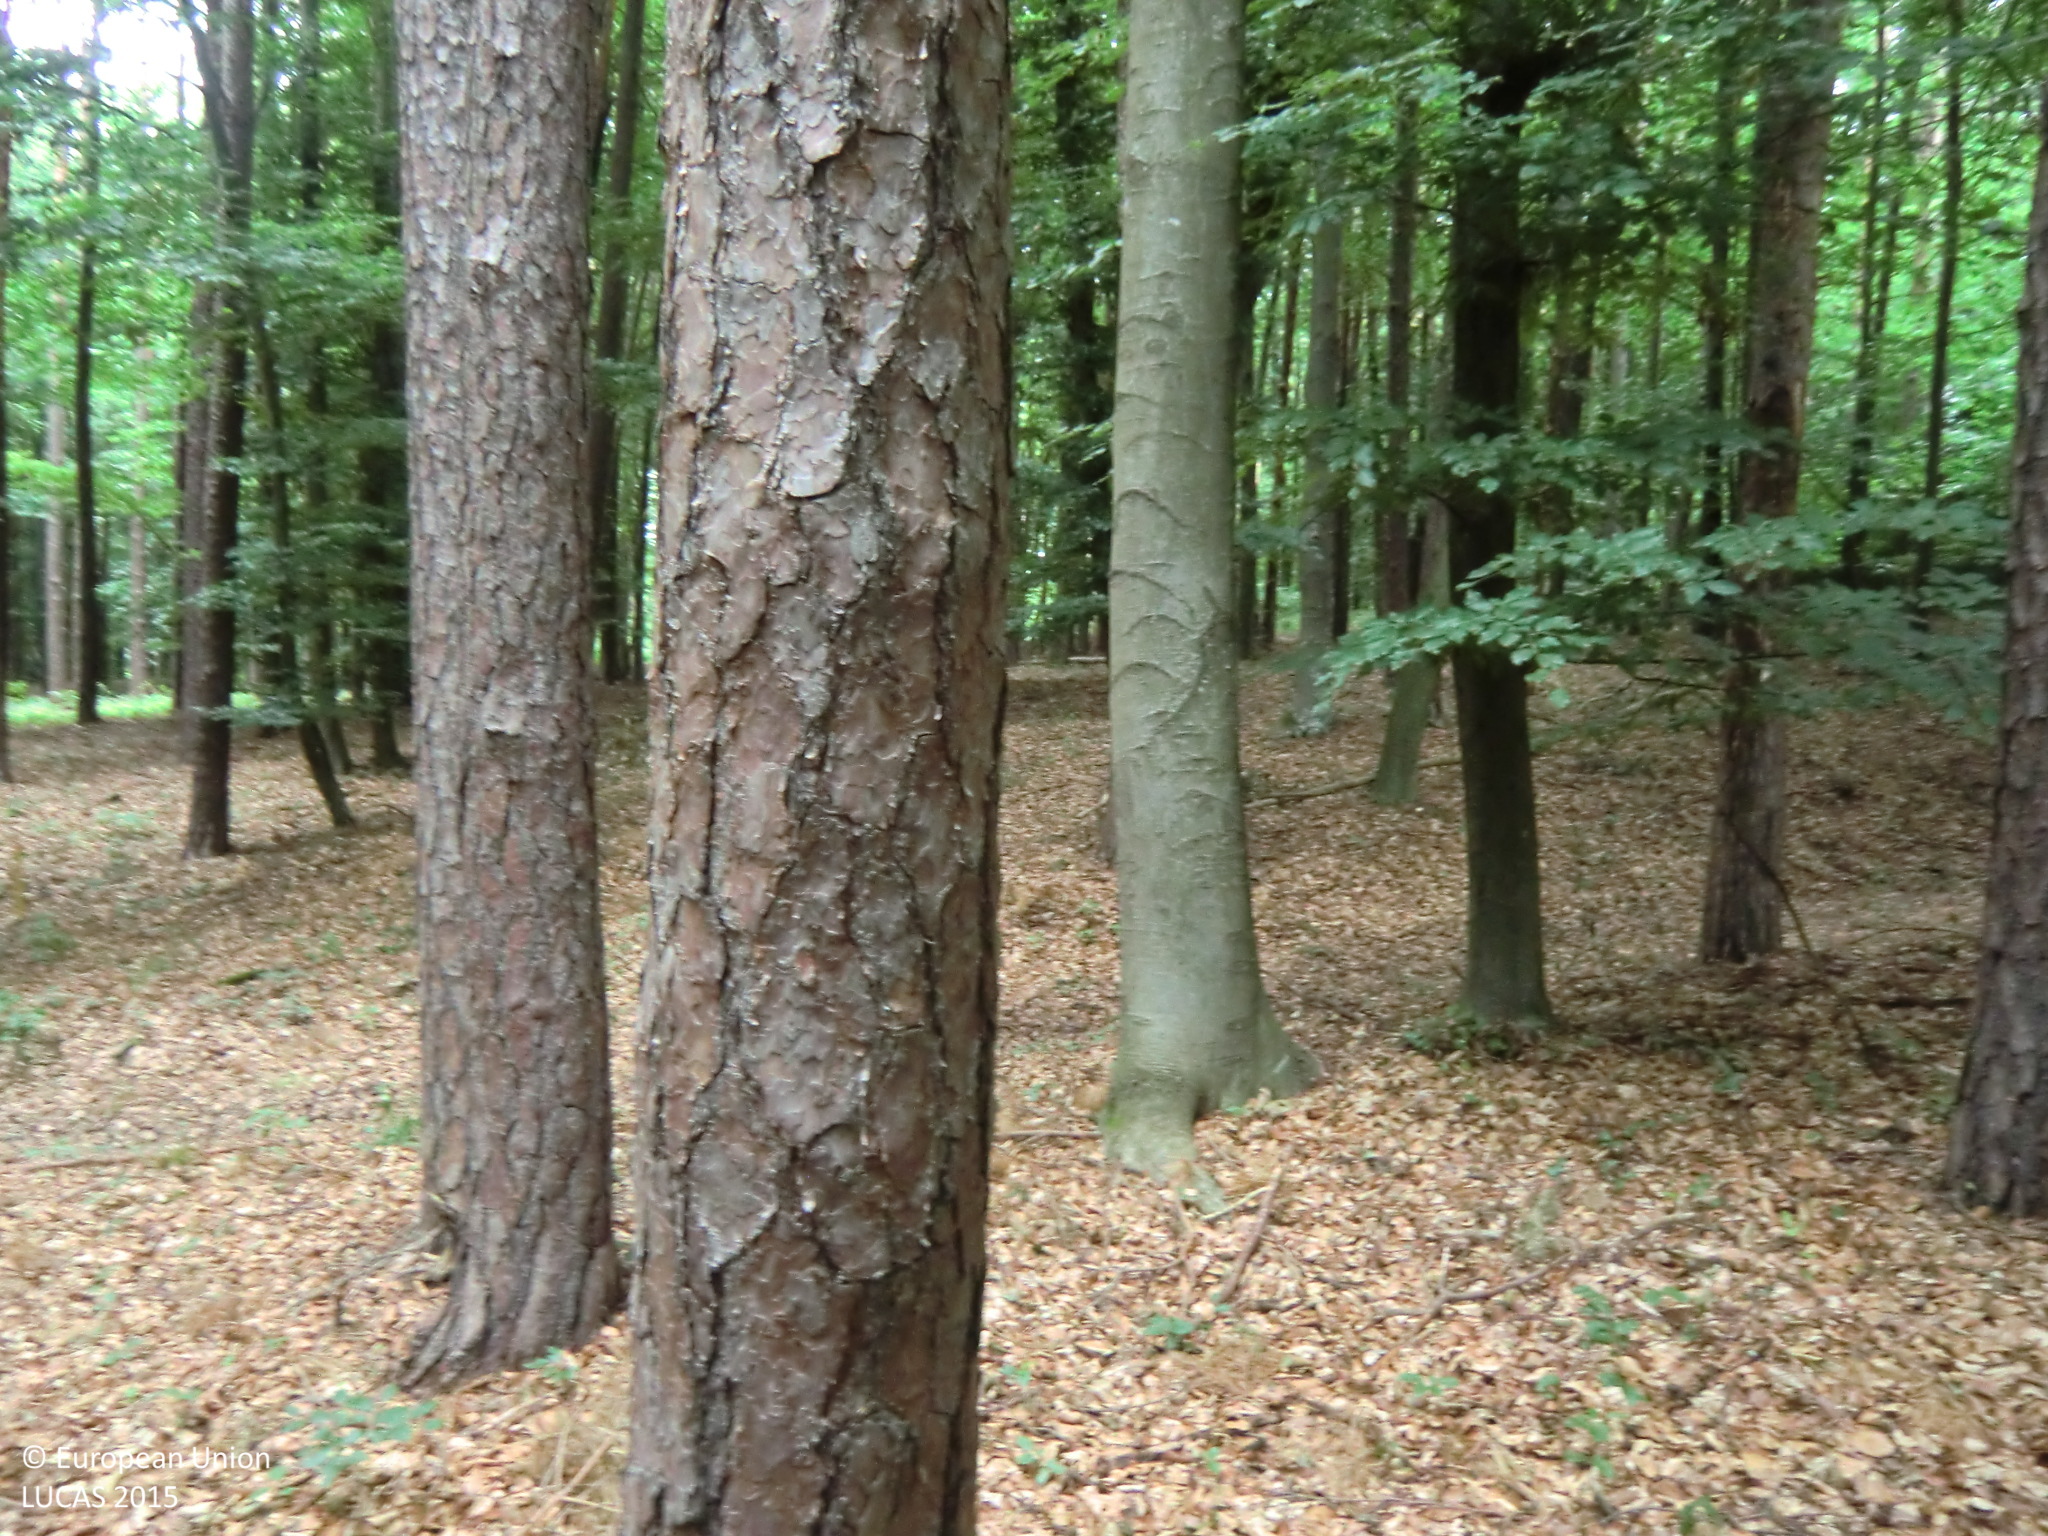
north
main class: Woodland
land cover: Pine dominated mixed woodland
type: hemiboreal forest and nemoral coniferous forest and mixed broadleaved-coniferous forest
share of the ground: > 75 %
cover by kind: coniferous forest trees 40 %, broadleaved forest trees 40 %, unconsolidated bare surface 20 %
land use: Forestry
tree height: > 5 m
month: June
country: AT
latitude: 47.2652
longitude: 16.0152
